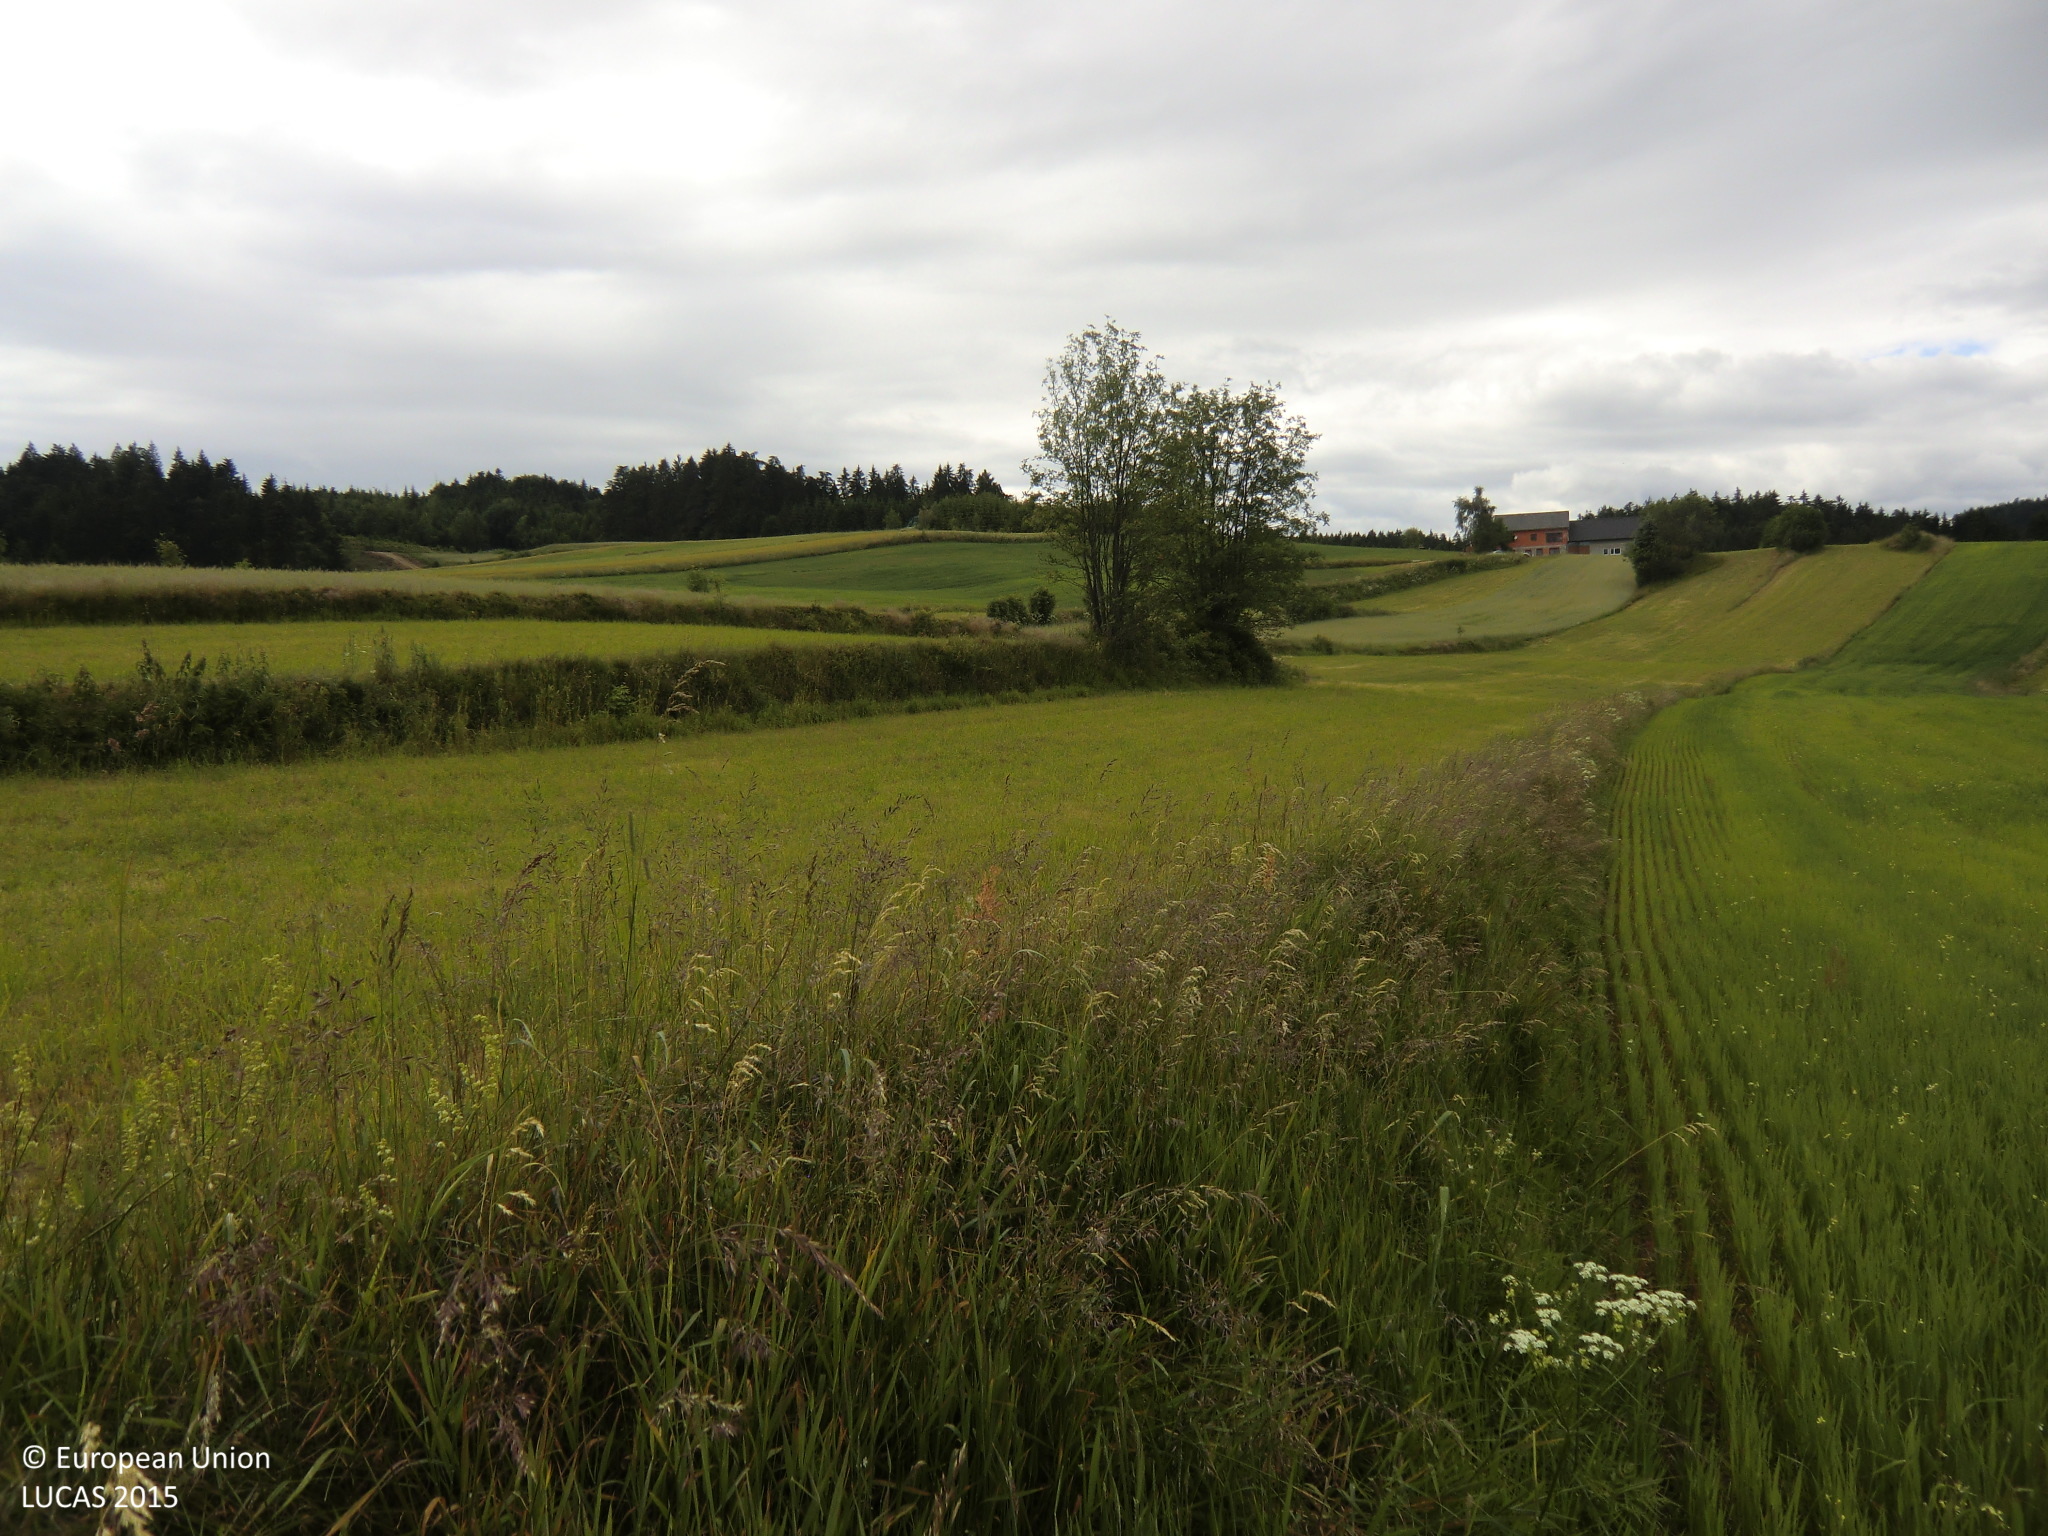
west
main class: Cropland
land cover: Rye
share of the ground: > 75 %
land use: Agriculture (excluding fallow land and kitchen gardens)
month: June
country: AT
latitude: 48.4351
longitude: 14.9891
